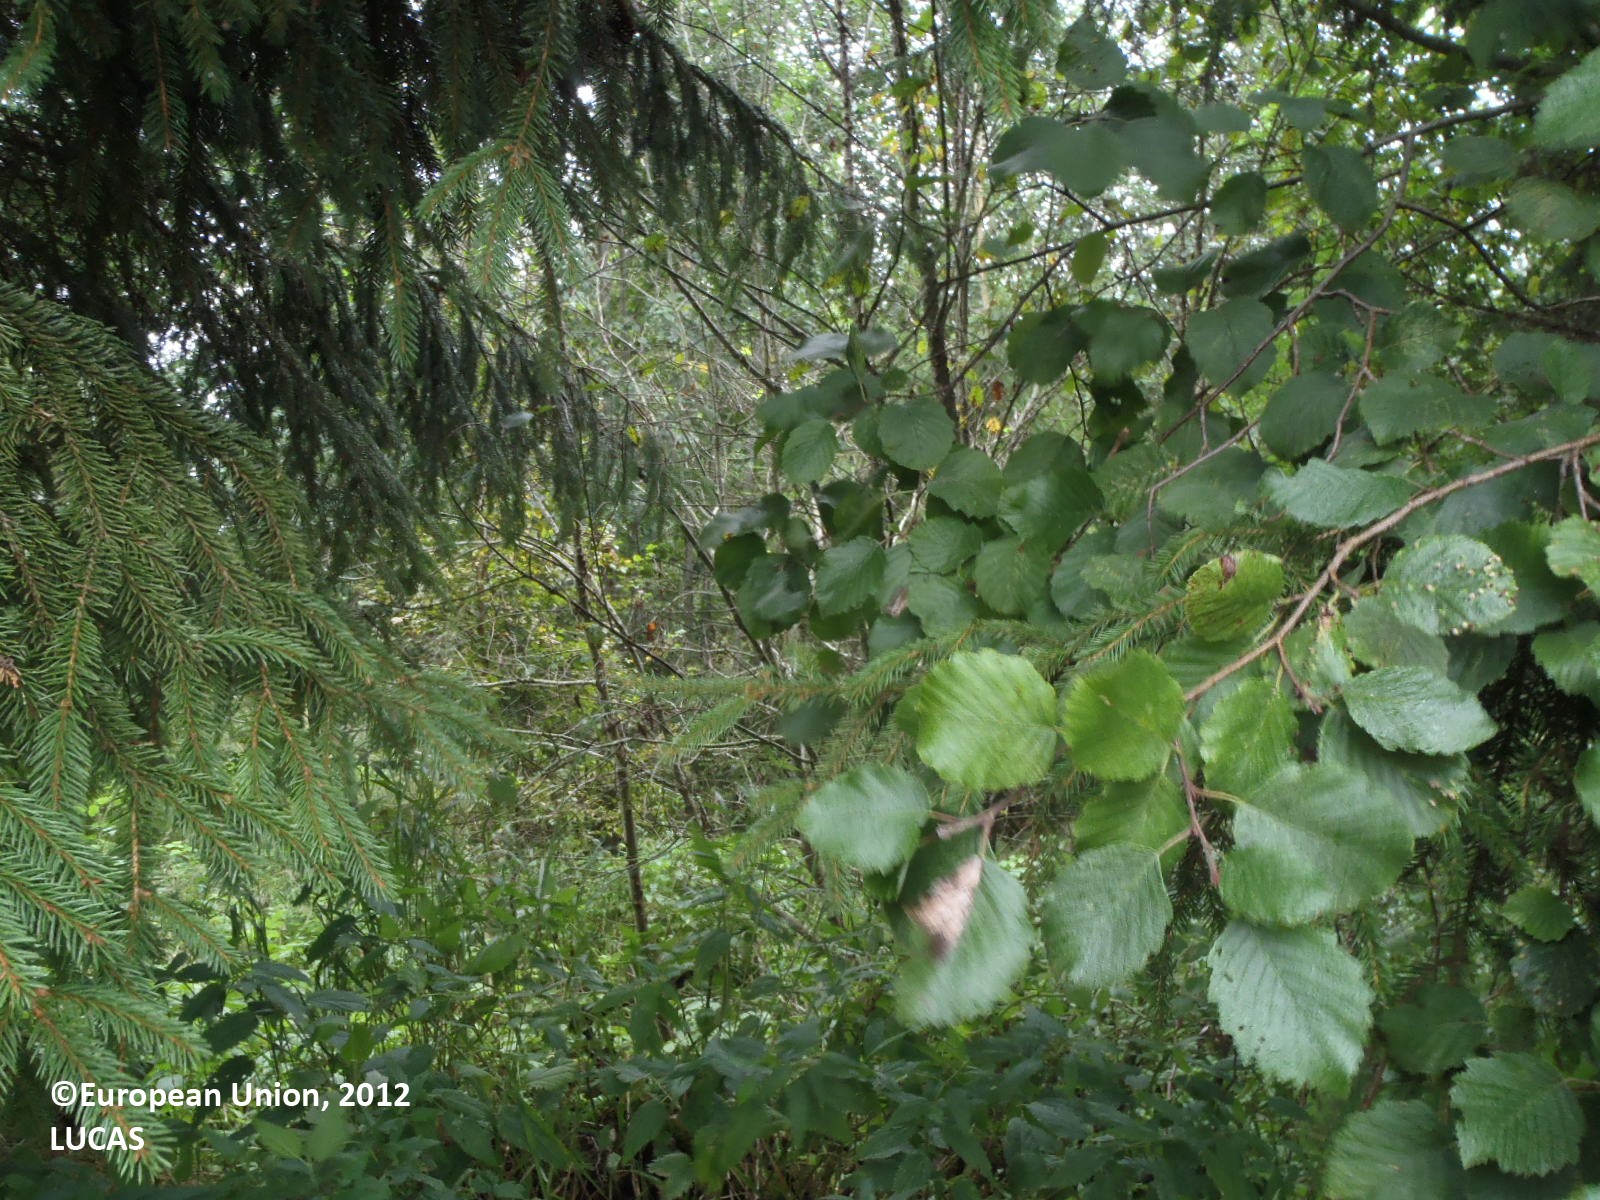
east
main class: Woodland
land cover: Spruce dominated mixed woodland
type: boreal forest
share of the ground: > 75 %
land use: Forestry
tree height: > 5 m
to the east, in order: Spruce dominated mixed woodland; Ditches and canals; Tracks; Spruce dominated mixed woodland; Ditches and canals; Other bare soil; Oats
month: August
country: FI
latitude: 60.6886
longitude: 22.2056
